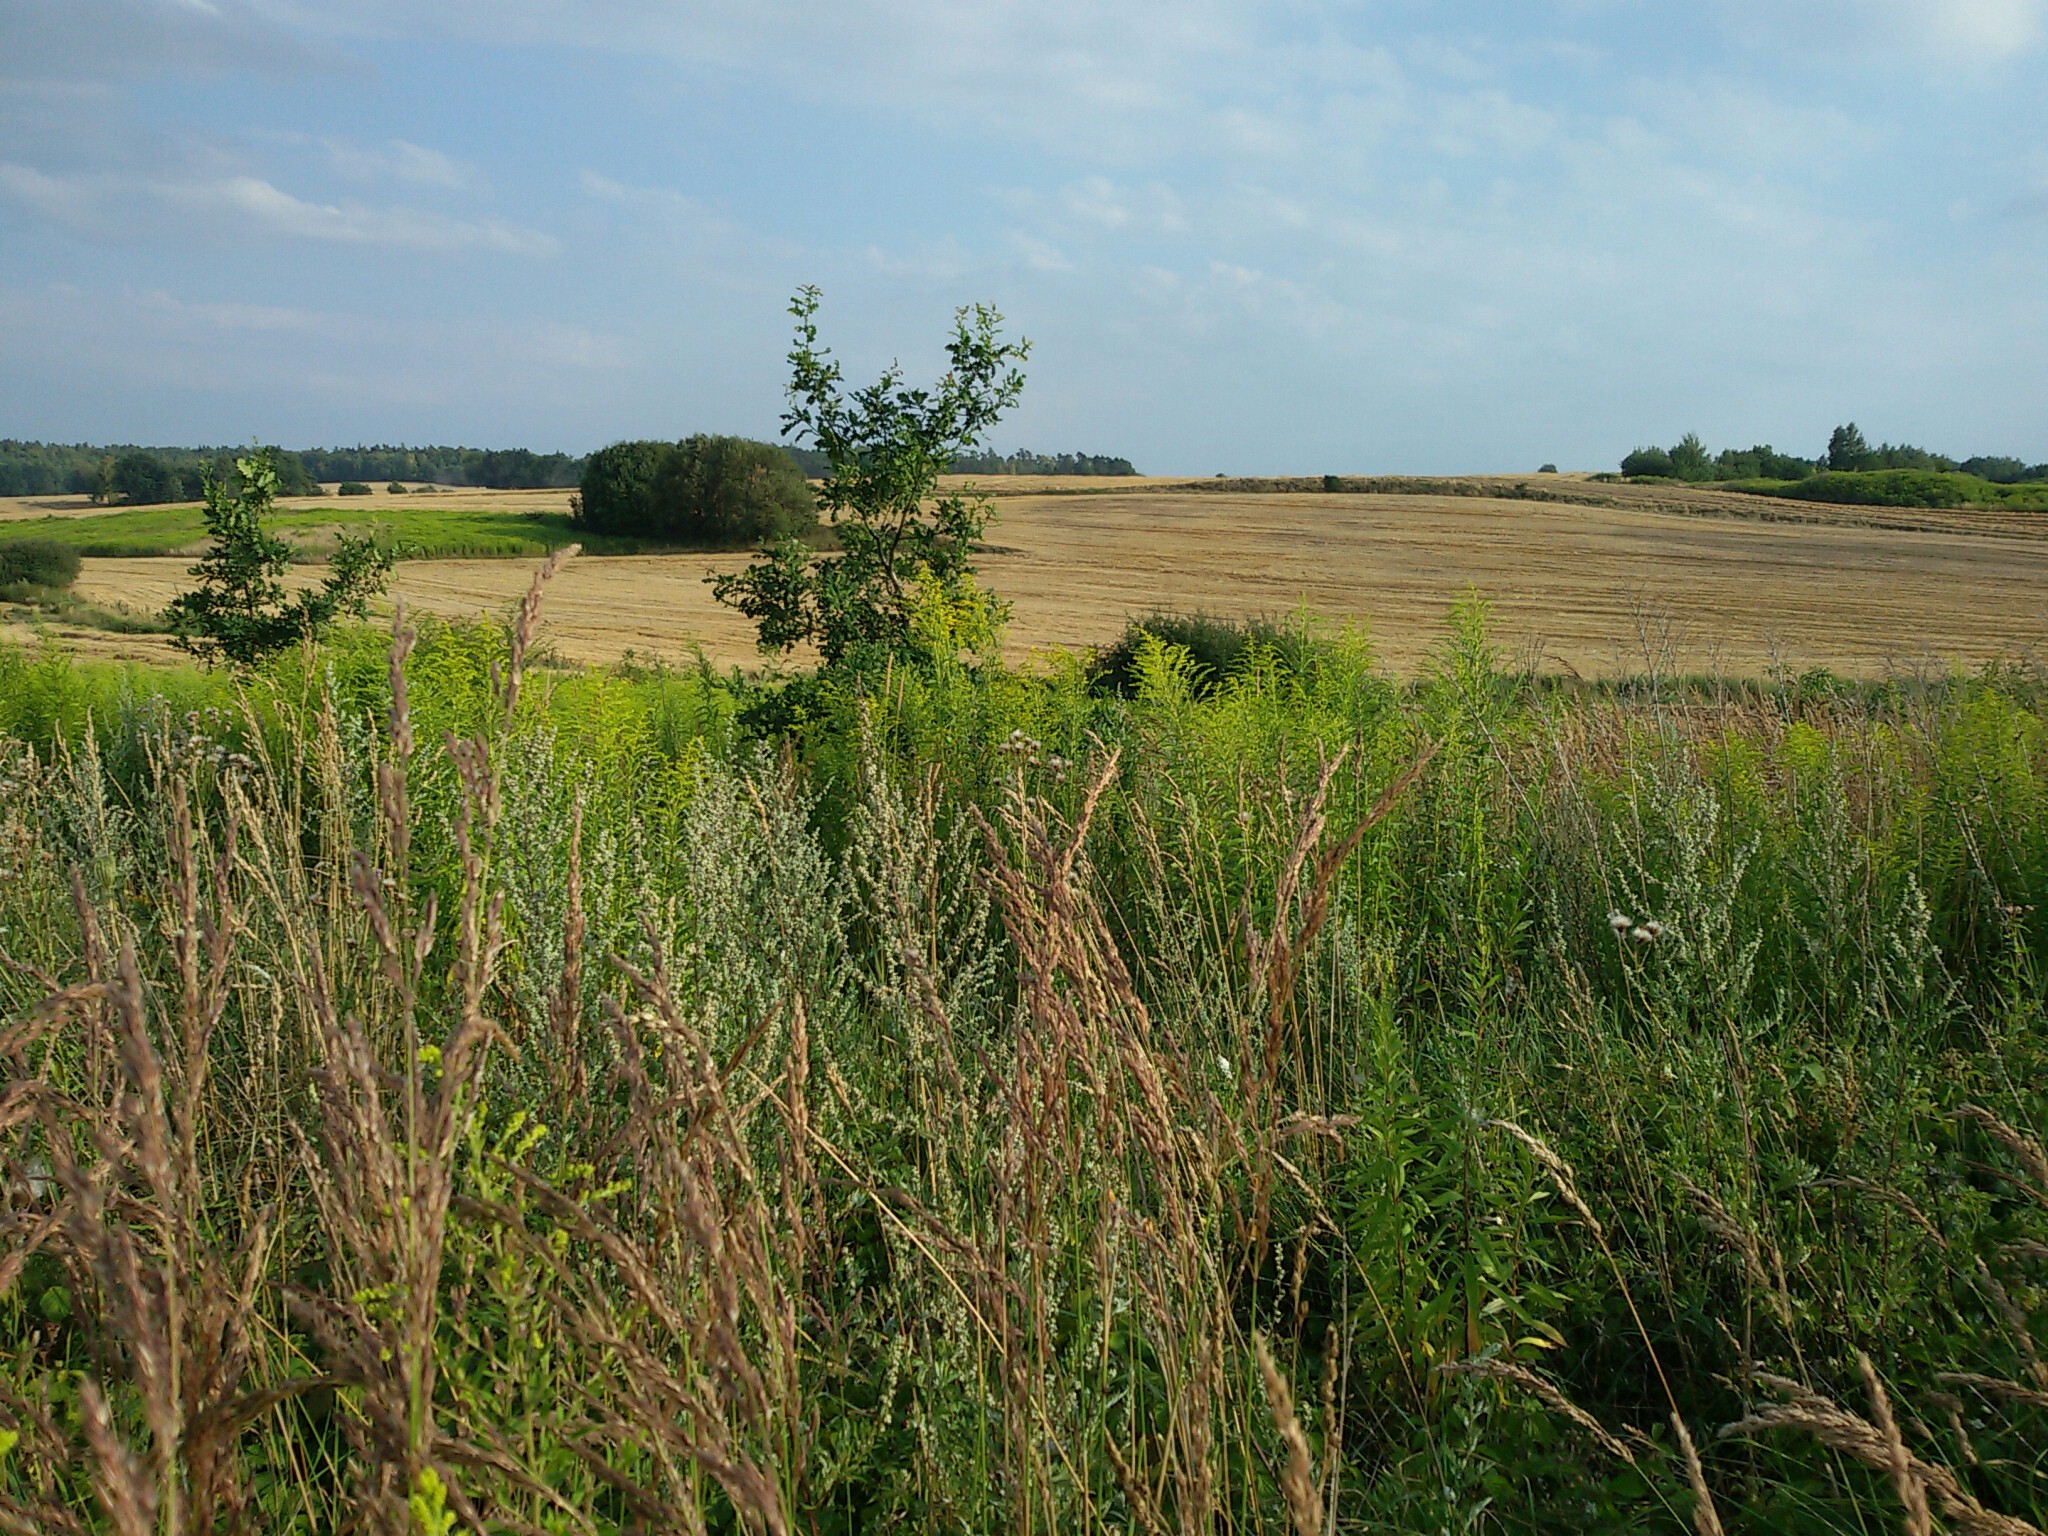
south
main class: Grassland
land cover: Spontaneously vegetated surfaces
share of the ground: > 75 %
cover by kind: herbaceous plants 100 %
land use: Semi-natural and natural areas not in use
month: August
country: PL
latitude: 51.1946
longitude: 15.7145
